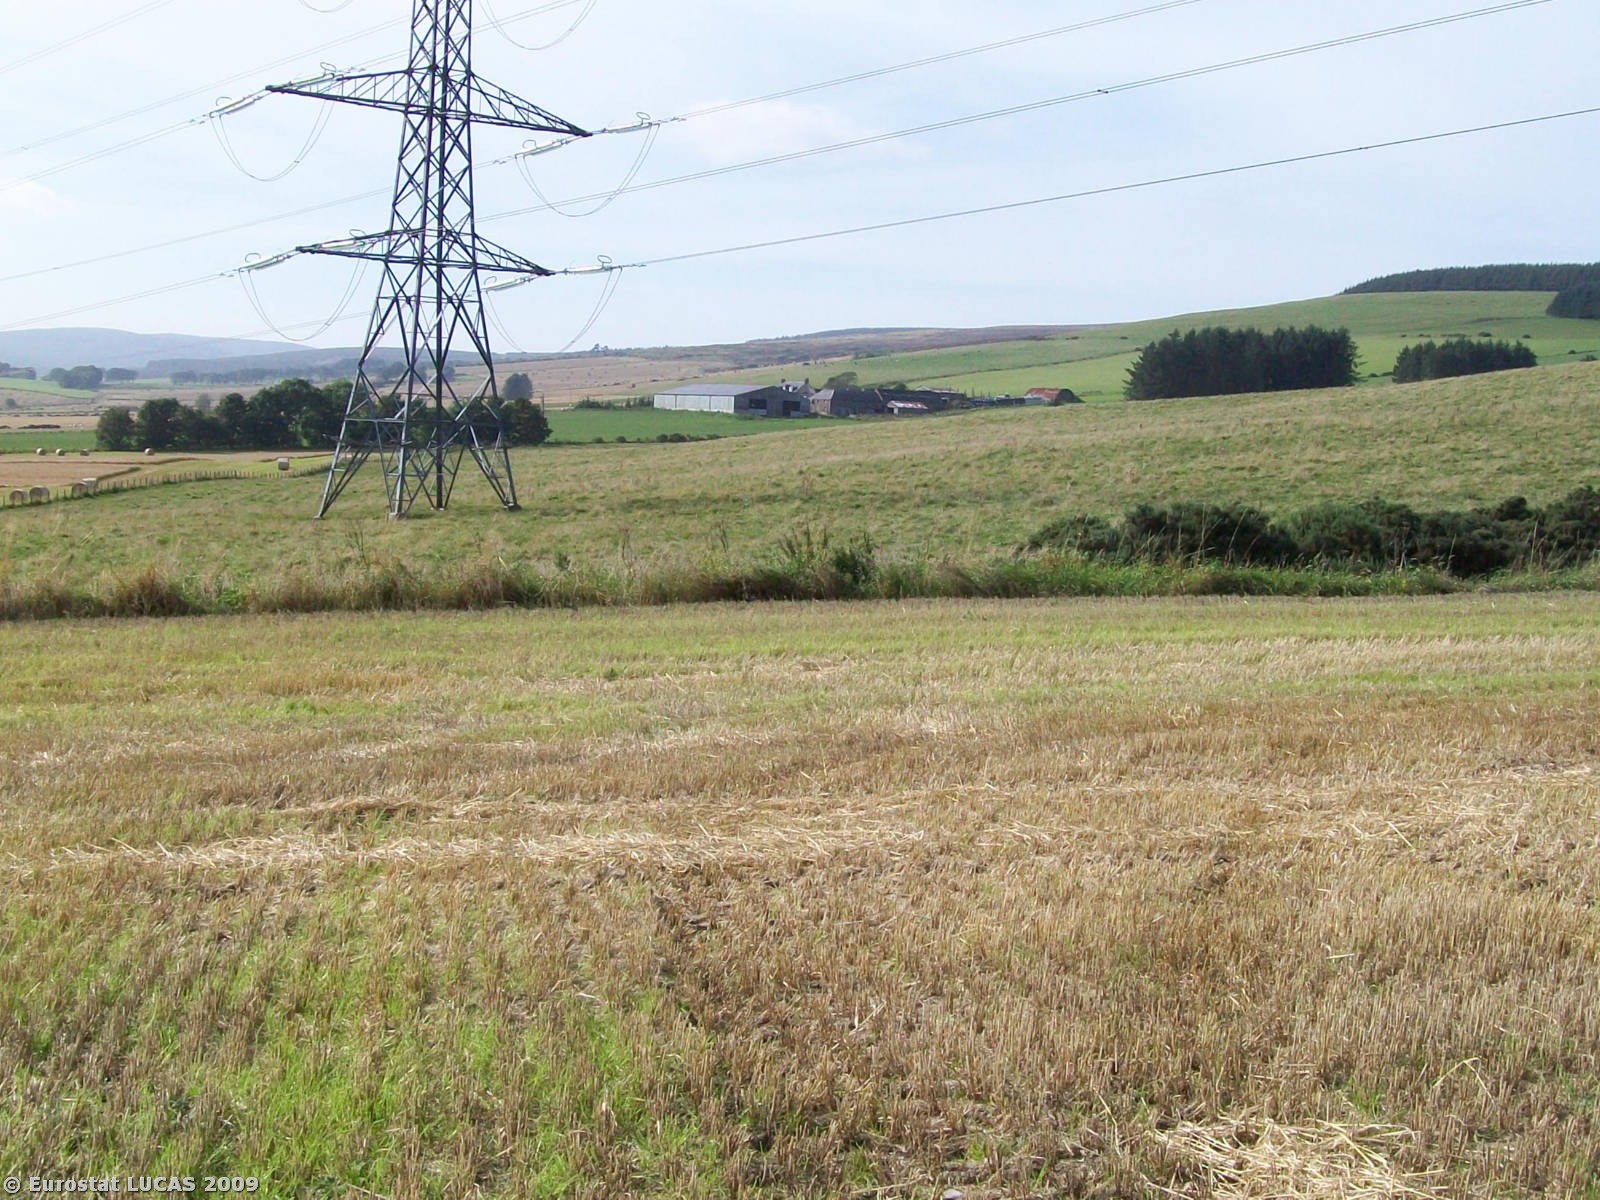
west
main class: Cropland
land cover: Barley
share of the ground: < 10 %
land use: Agriculture (excluding fallow land and kitchen gardens)
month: September
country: GB
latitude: 56.9529
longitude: -2.3682
